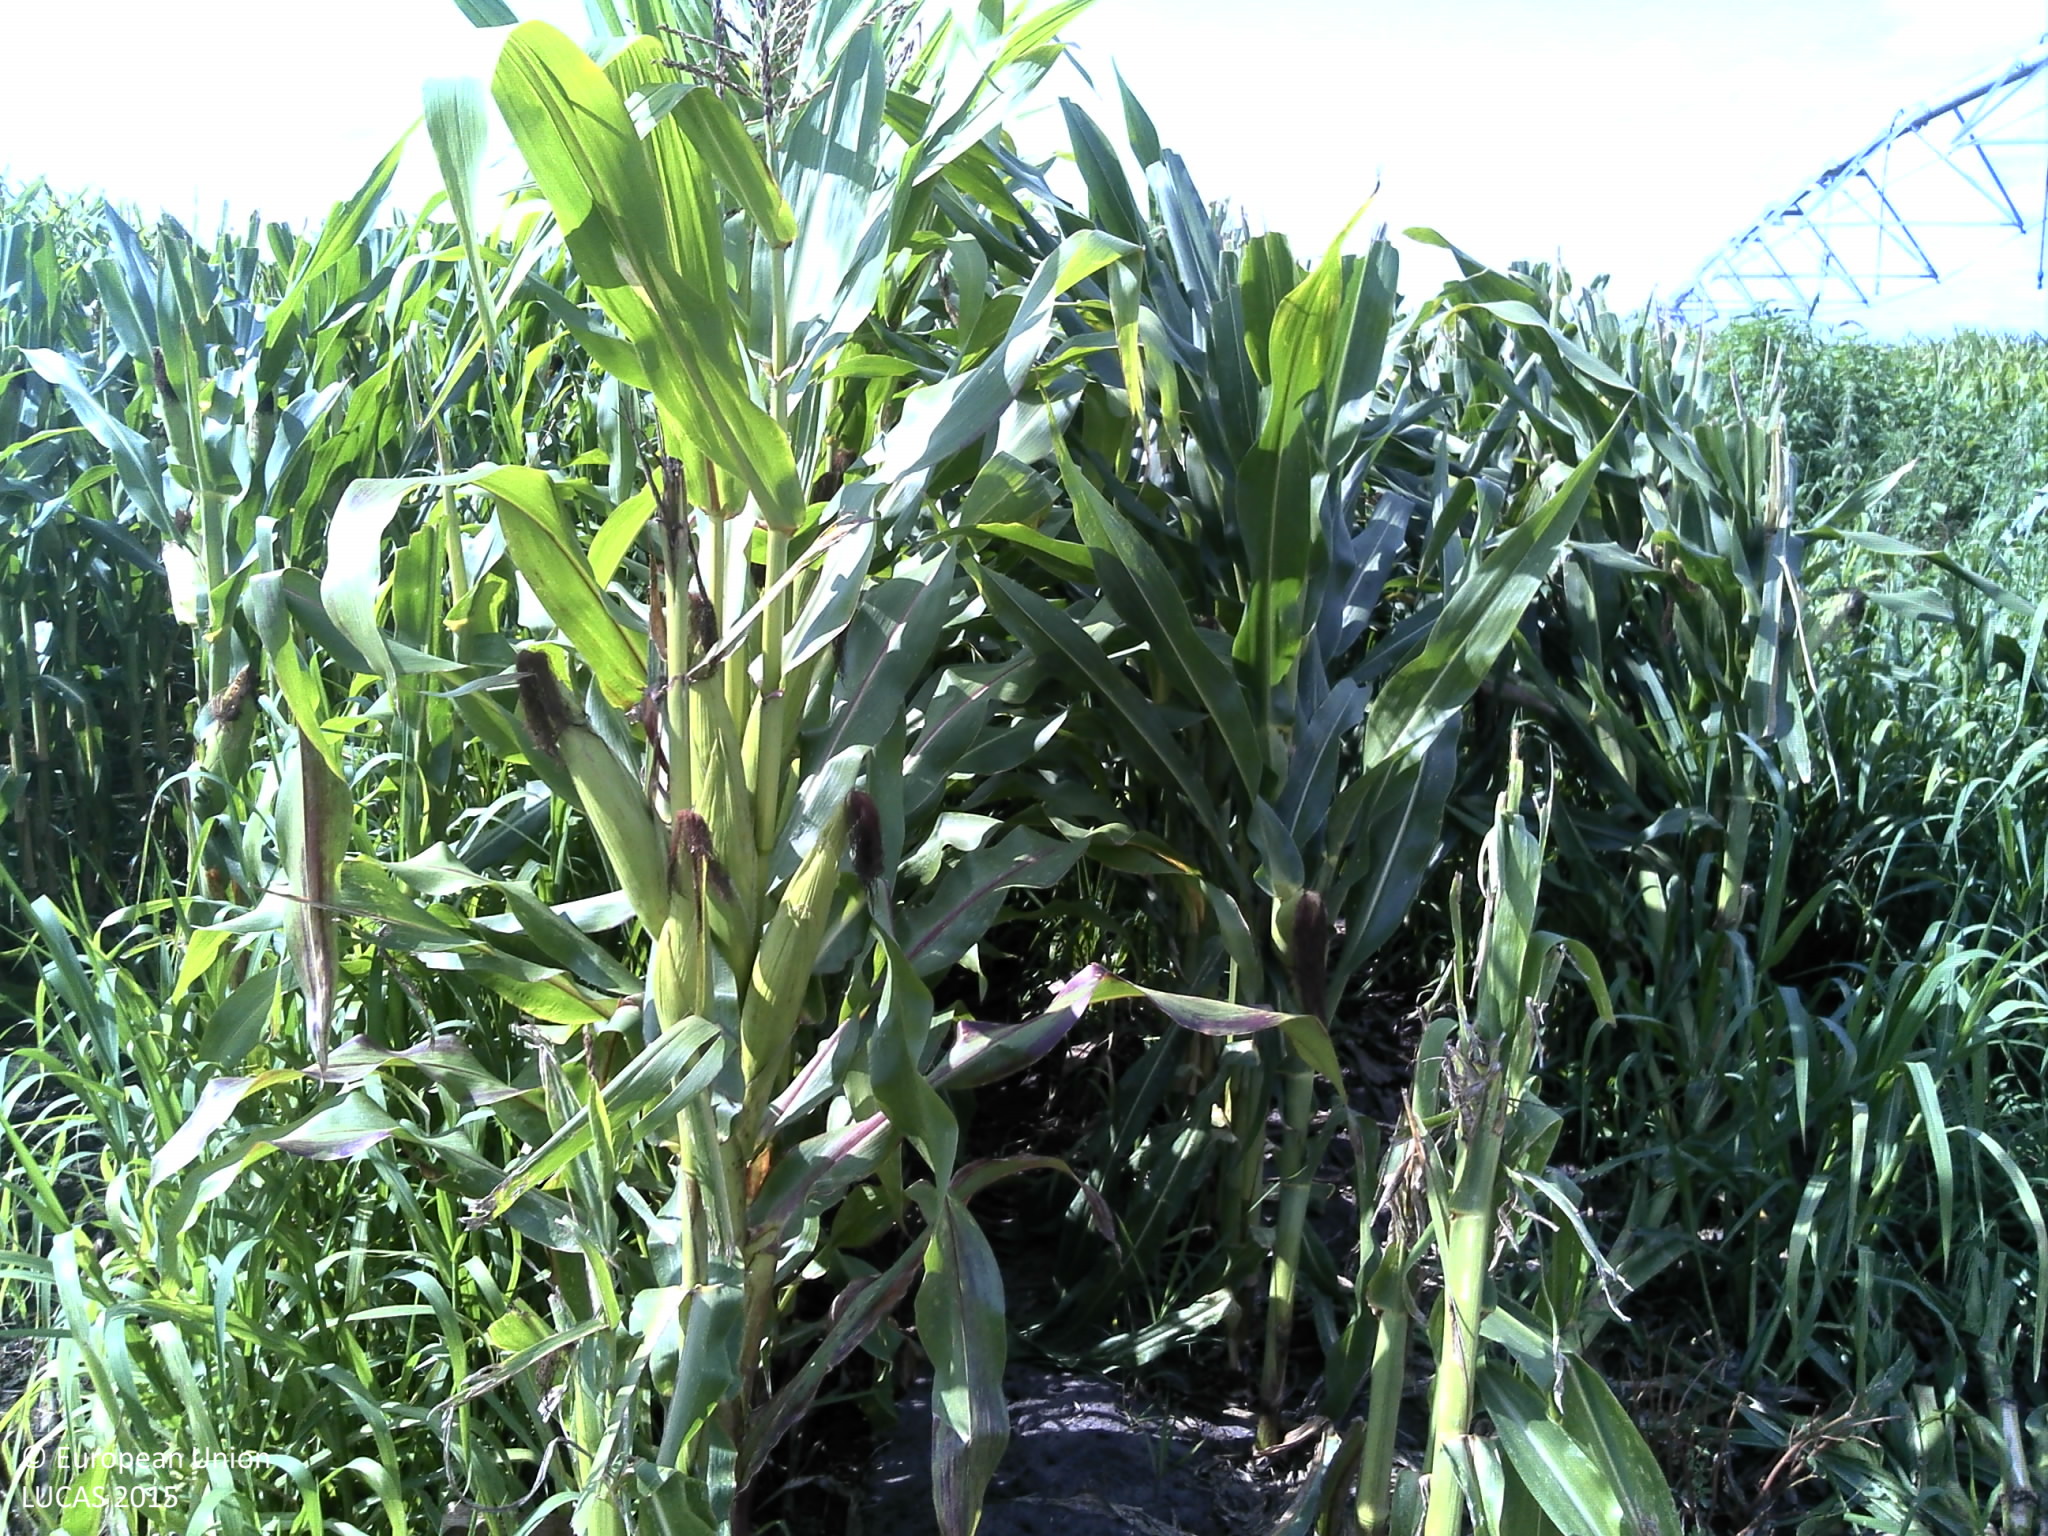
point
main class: Cropland
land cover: Maize
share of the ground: > 75 %
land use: Agriculture (excluding fallow land and kitchen gardens)
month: August
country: FR
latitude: 44.3752
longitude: -0.5451
